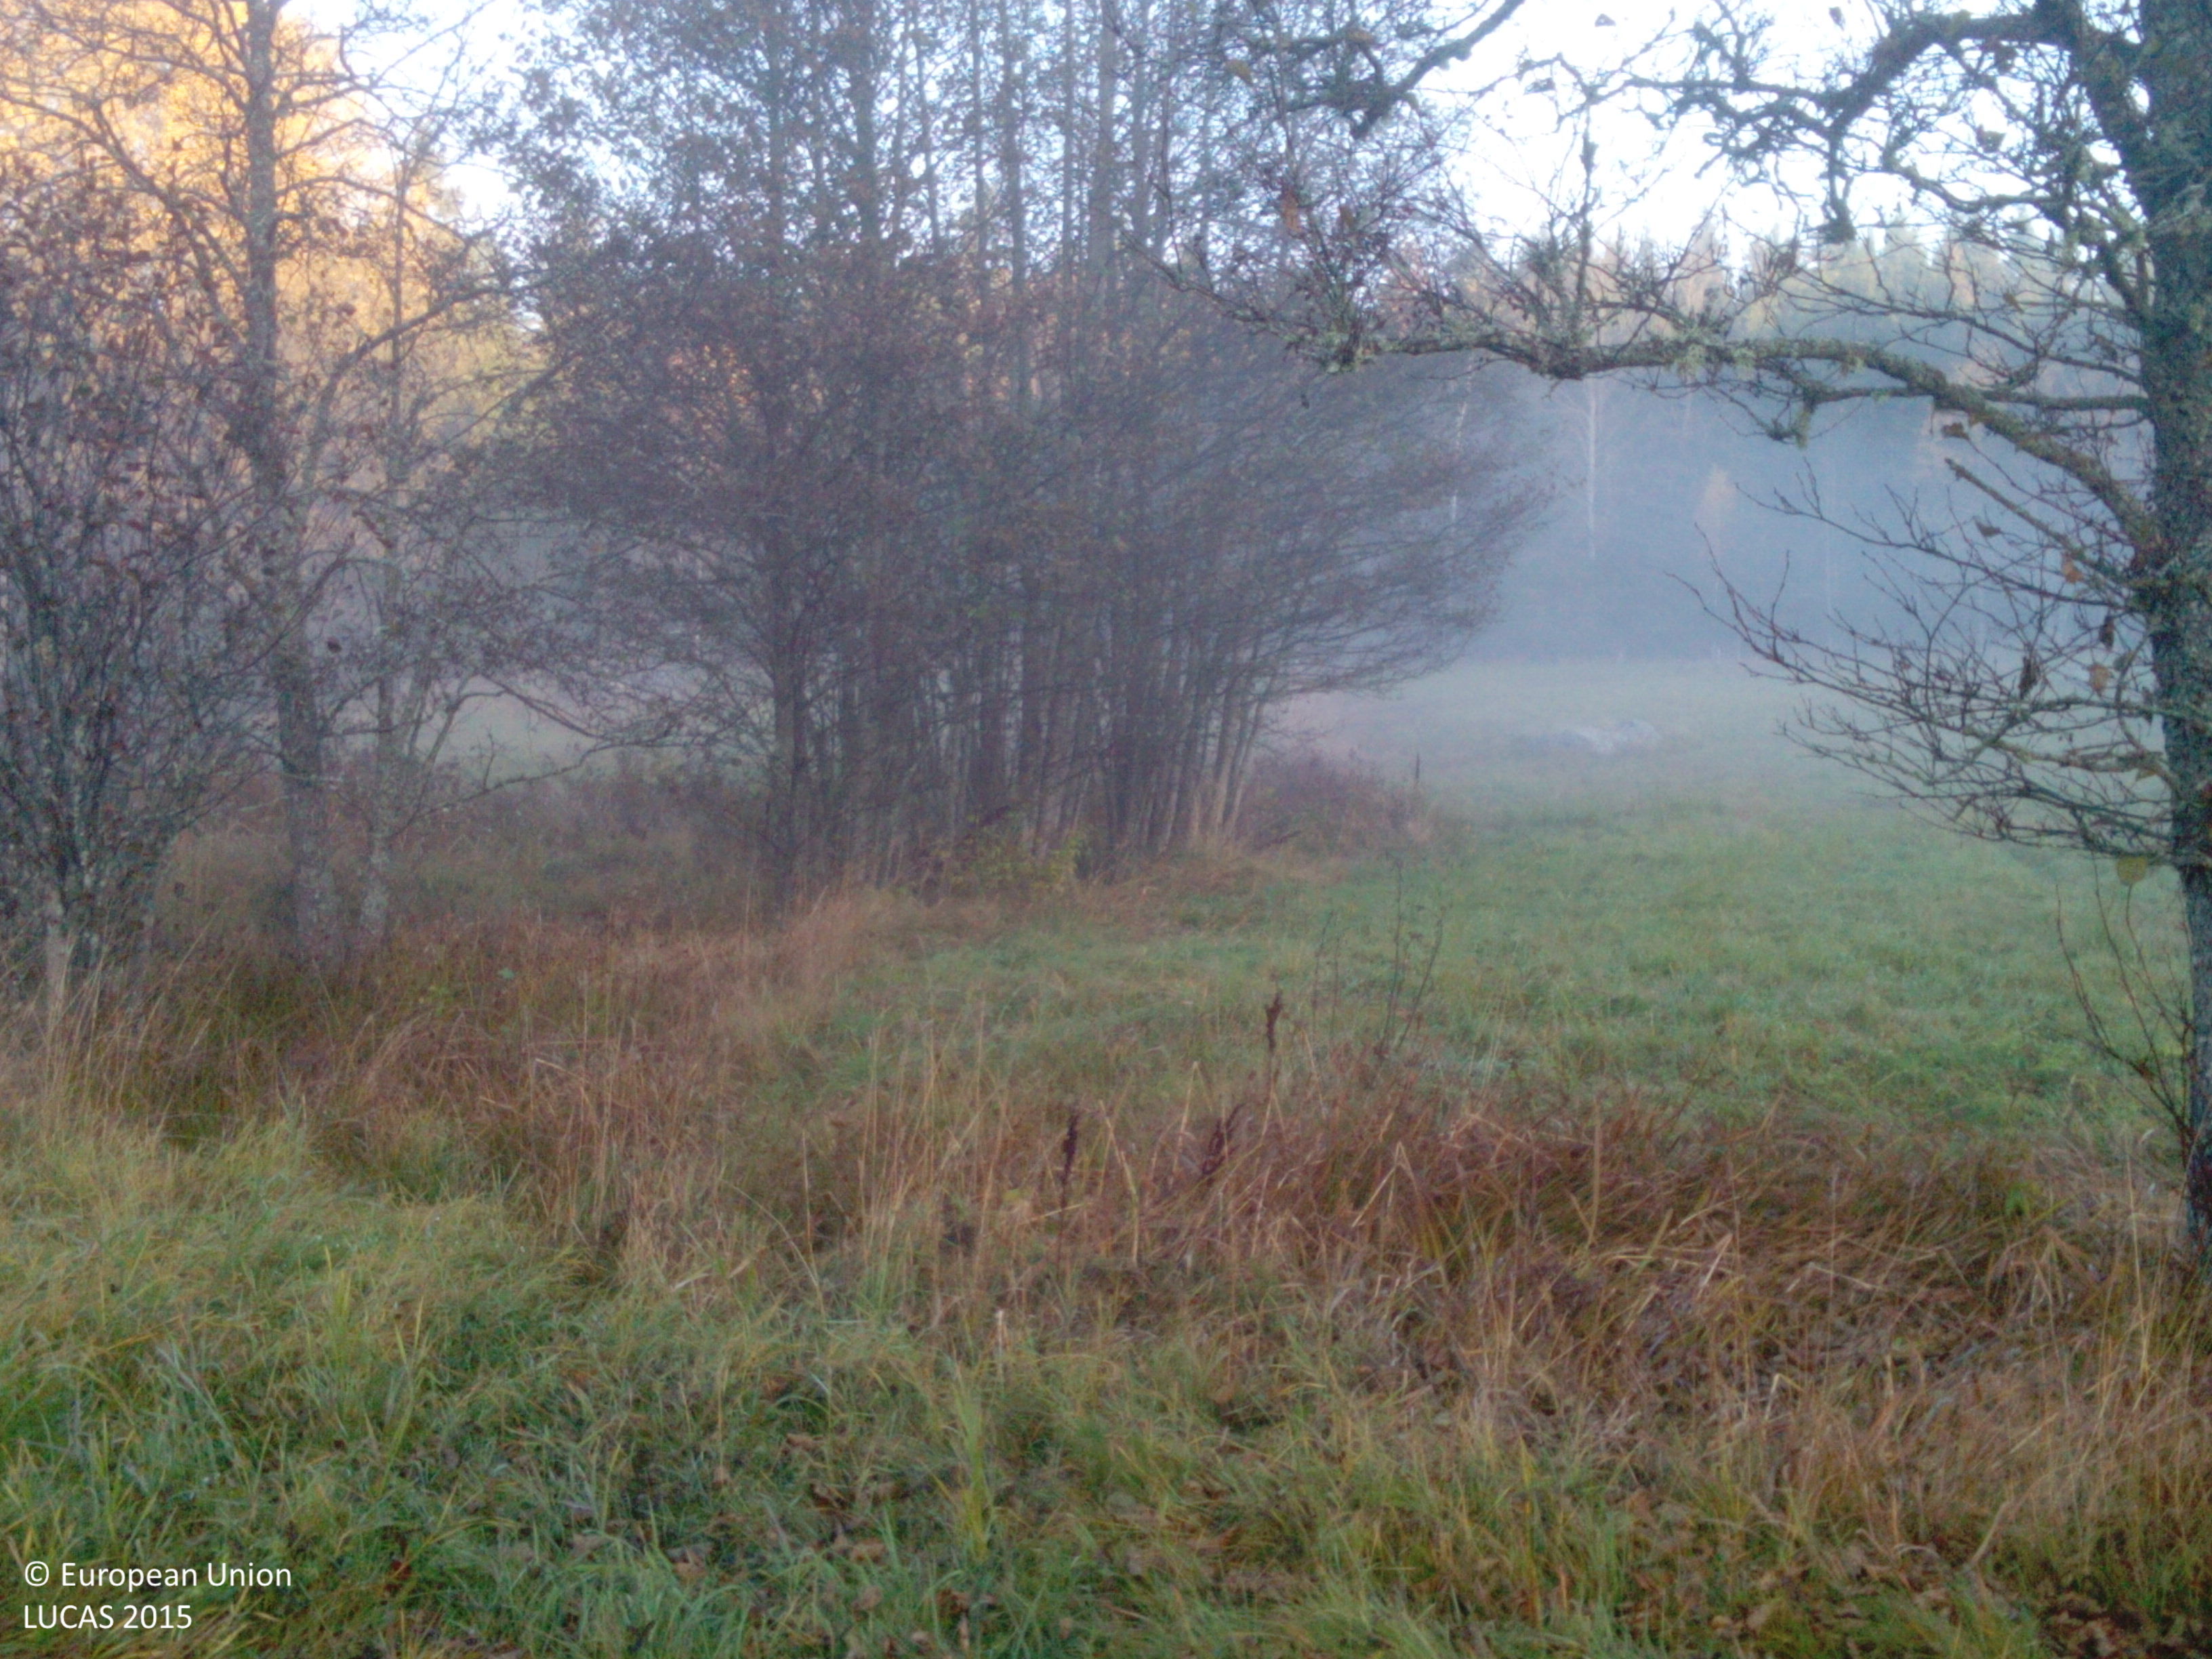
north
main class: Grassland
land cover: Grassland without tree/shrub cover
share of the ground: > 75 %
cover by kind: herbaceous plants 100 %
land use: Agriculture (excluding fallow land and kitchen gardens)
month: October
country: SE
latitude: 59.0945
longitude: 16.4349
